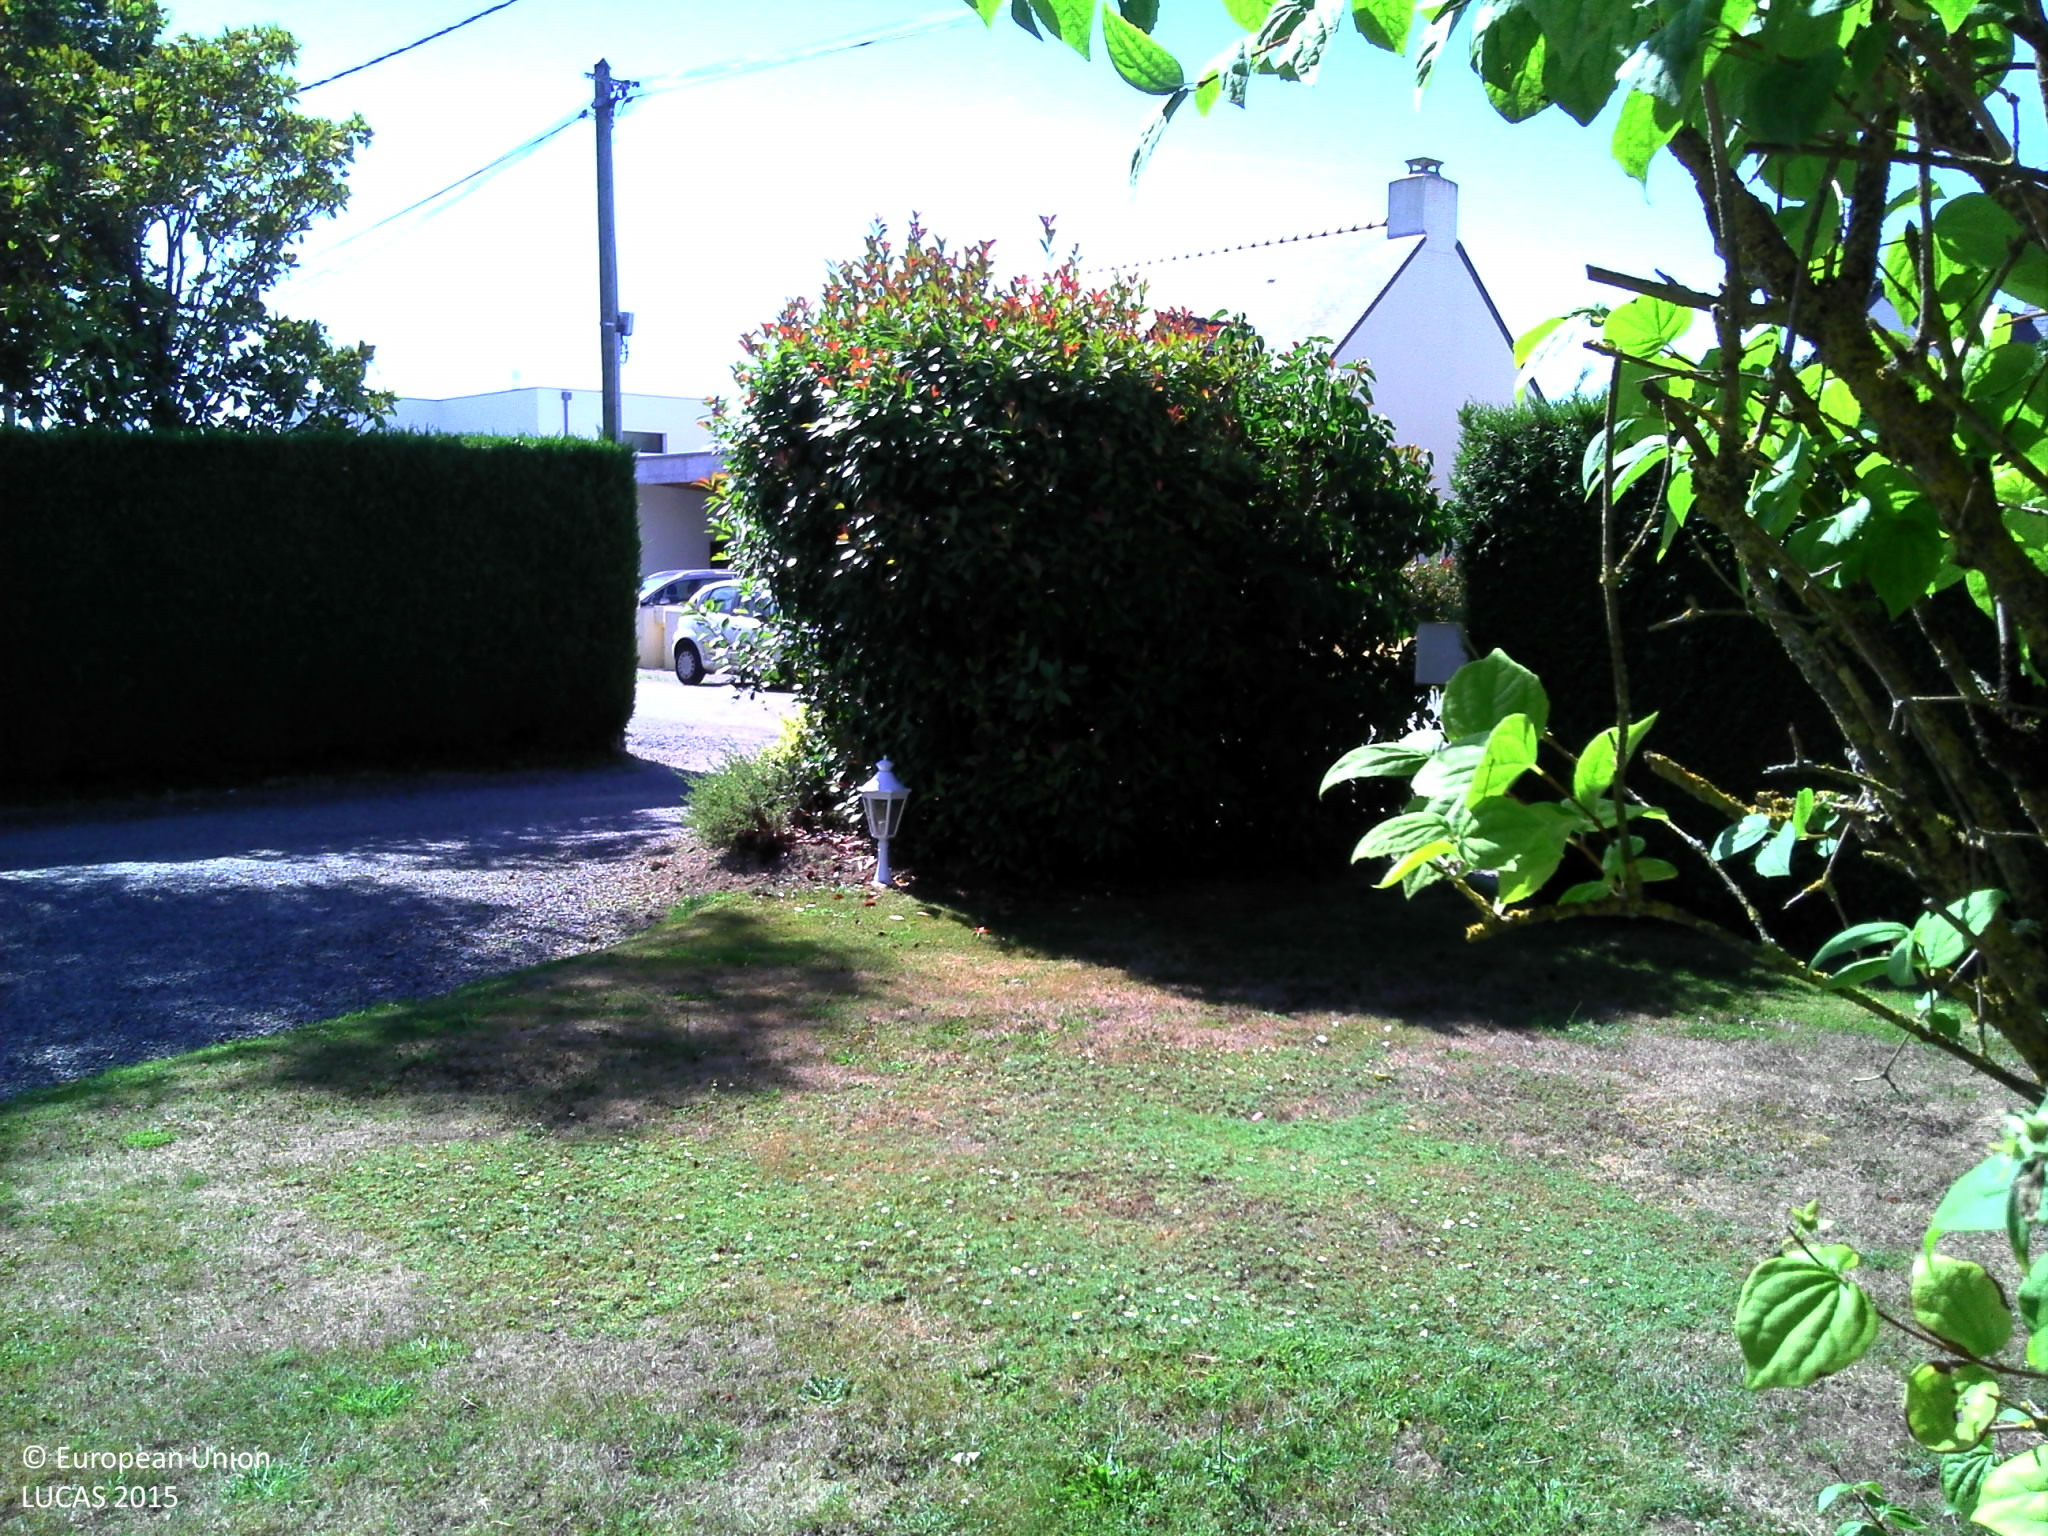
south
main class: Grassland
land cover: Grassland with sparse tree/shrub cover
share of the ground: > 75 %
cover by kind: herbaceous plants 95 %, broadleaved forest trees 5 %
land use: Residential
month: July
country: FR
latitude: 47.4445
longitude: -2.1053
